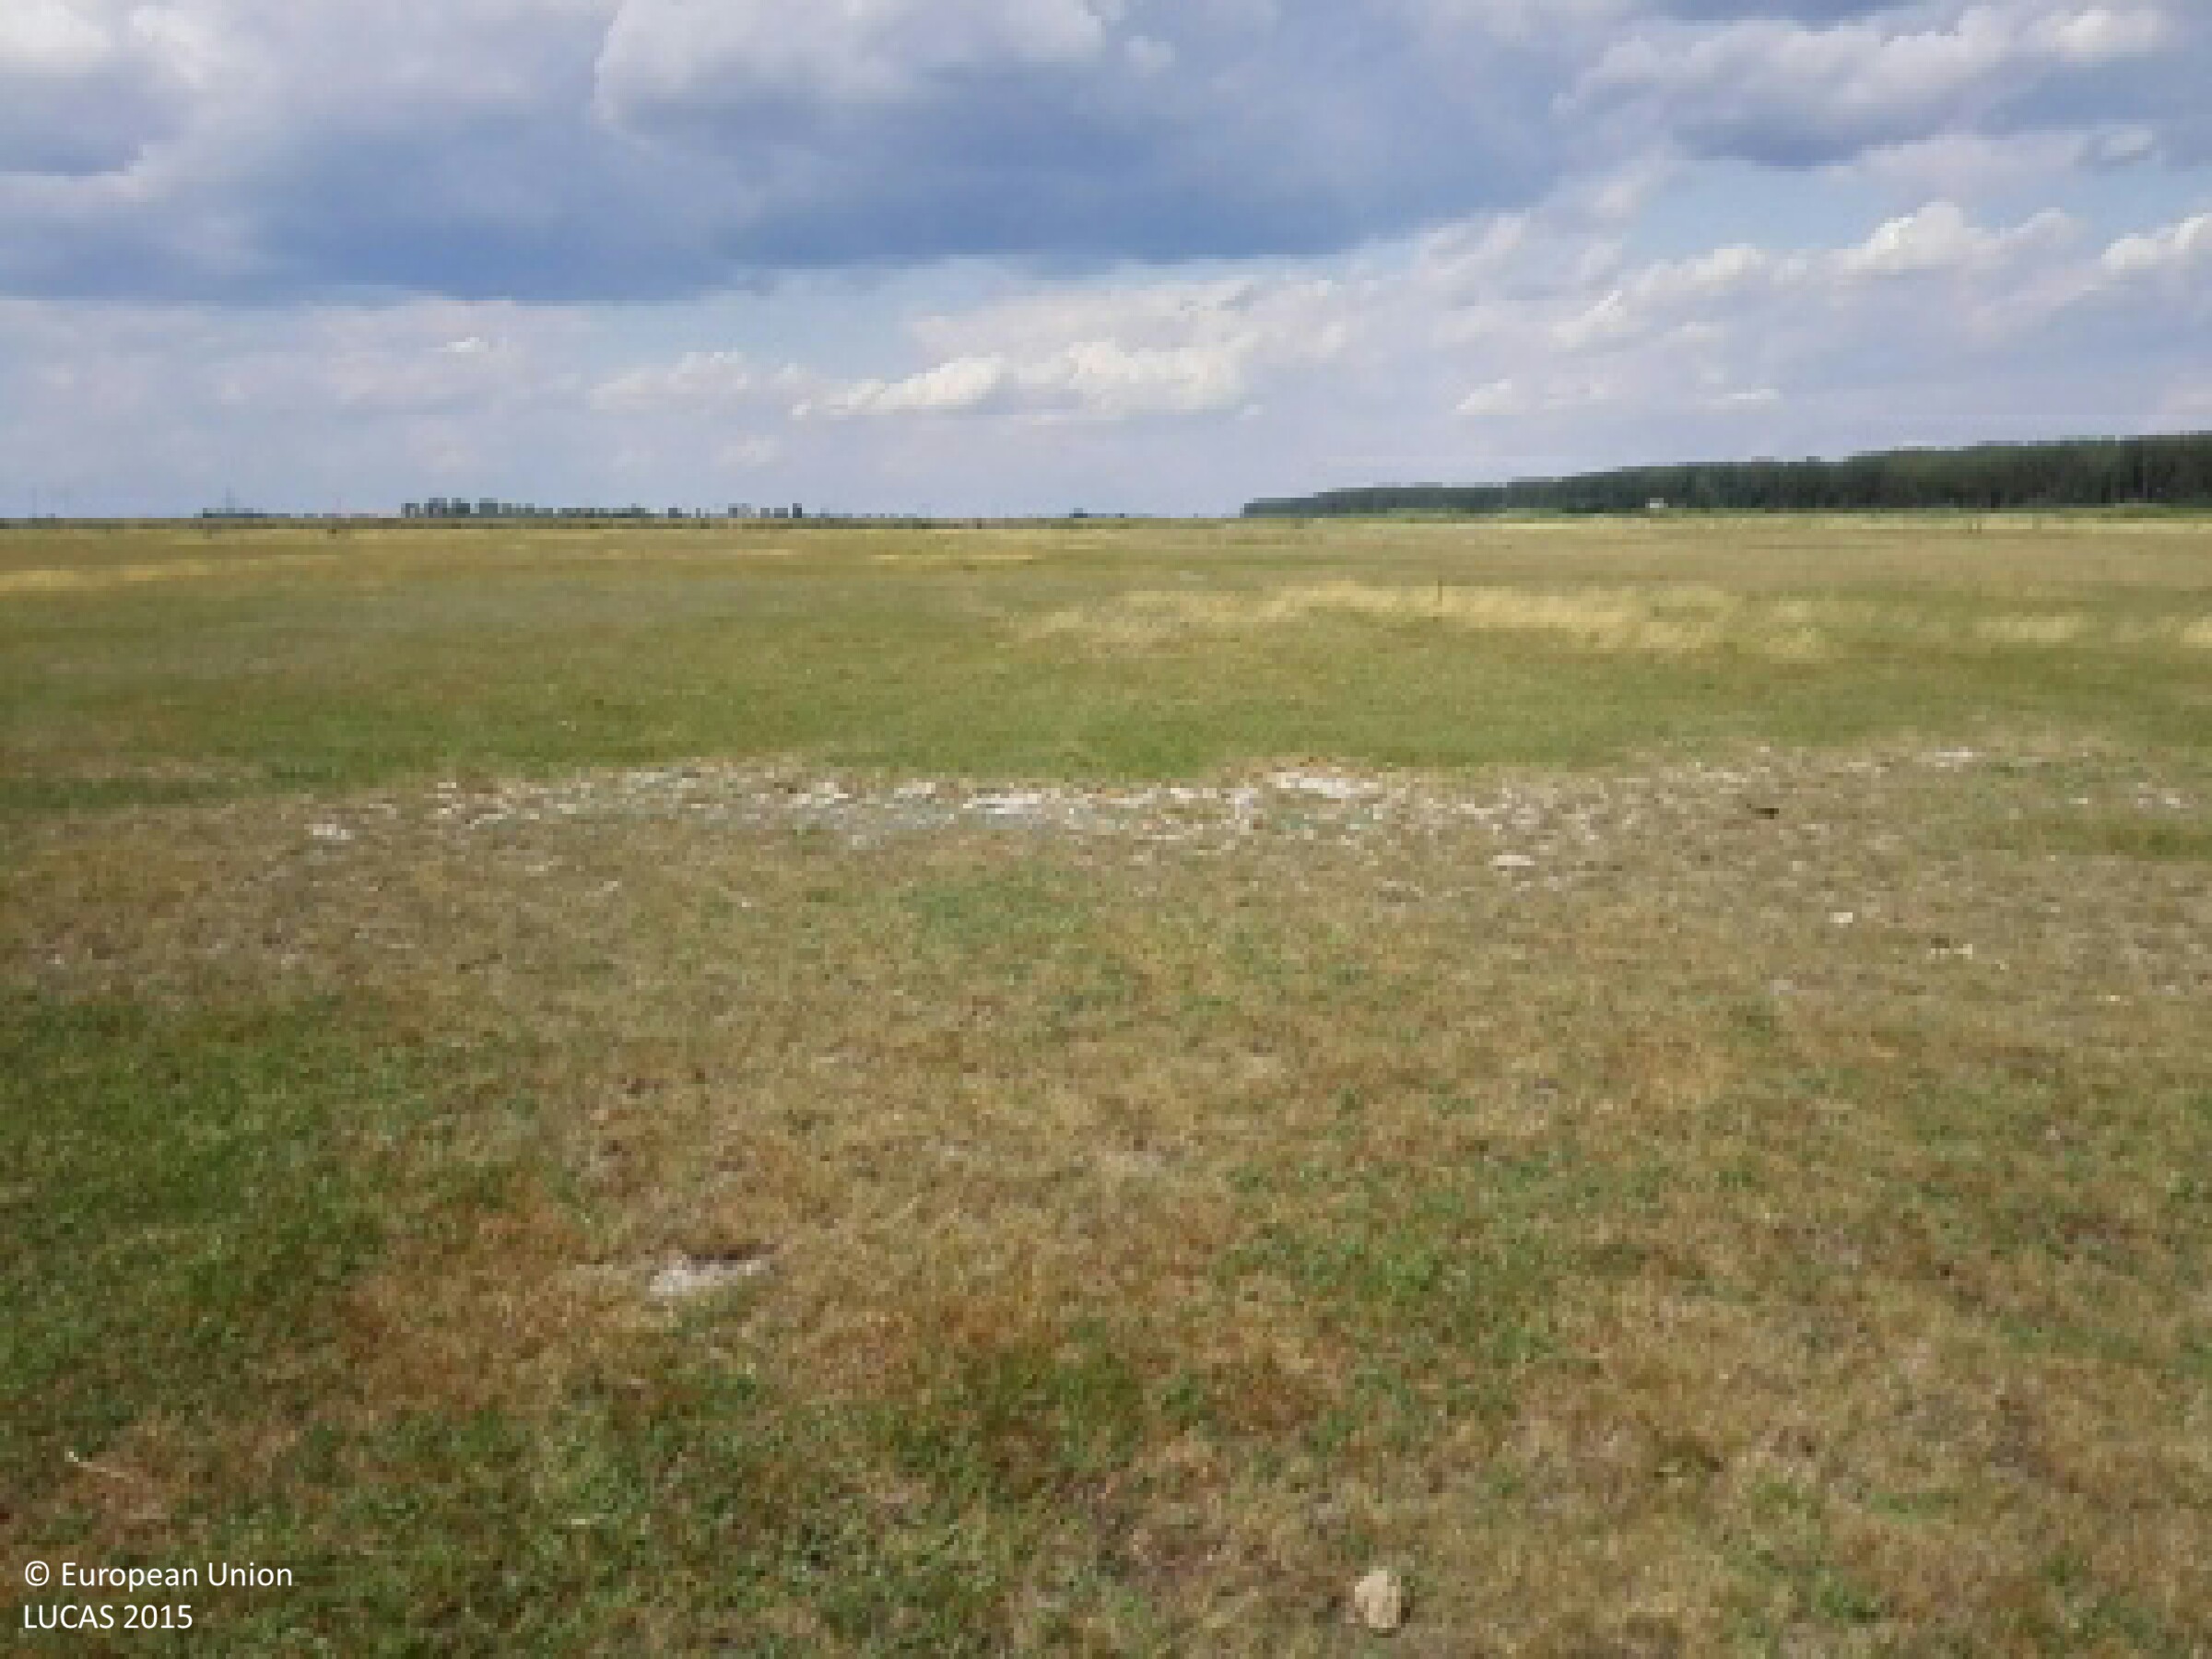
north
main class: Grassland
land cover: Grassland without tree/shrub cover
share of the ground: > 75 %
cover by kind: herbaceous plants 100 %
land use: Agriculture (excluding fallow land and kitchen gardens)
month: July
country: HU
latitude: 47.5119
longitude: 21.3137
